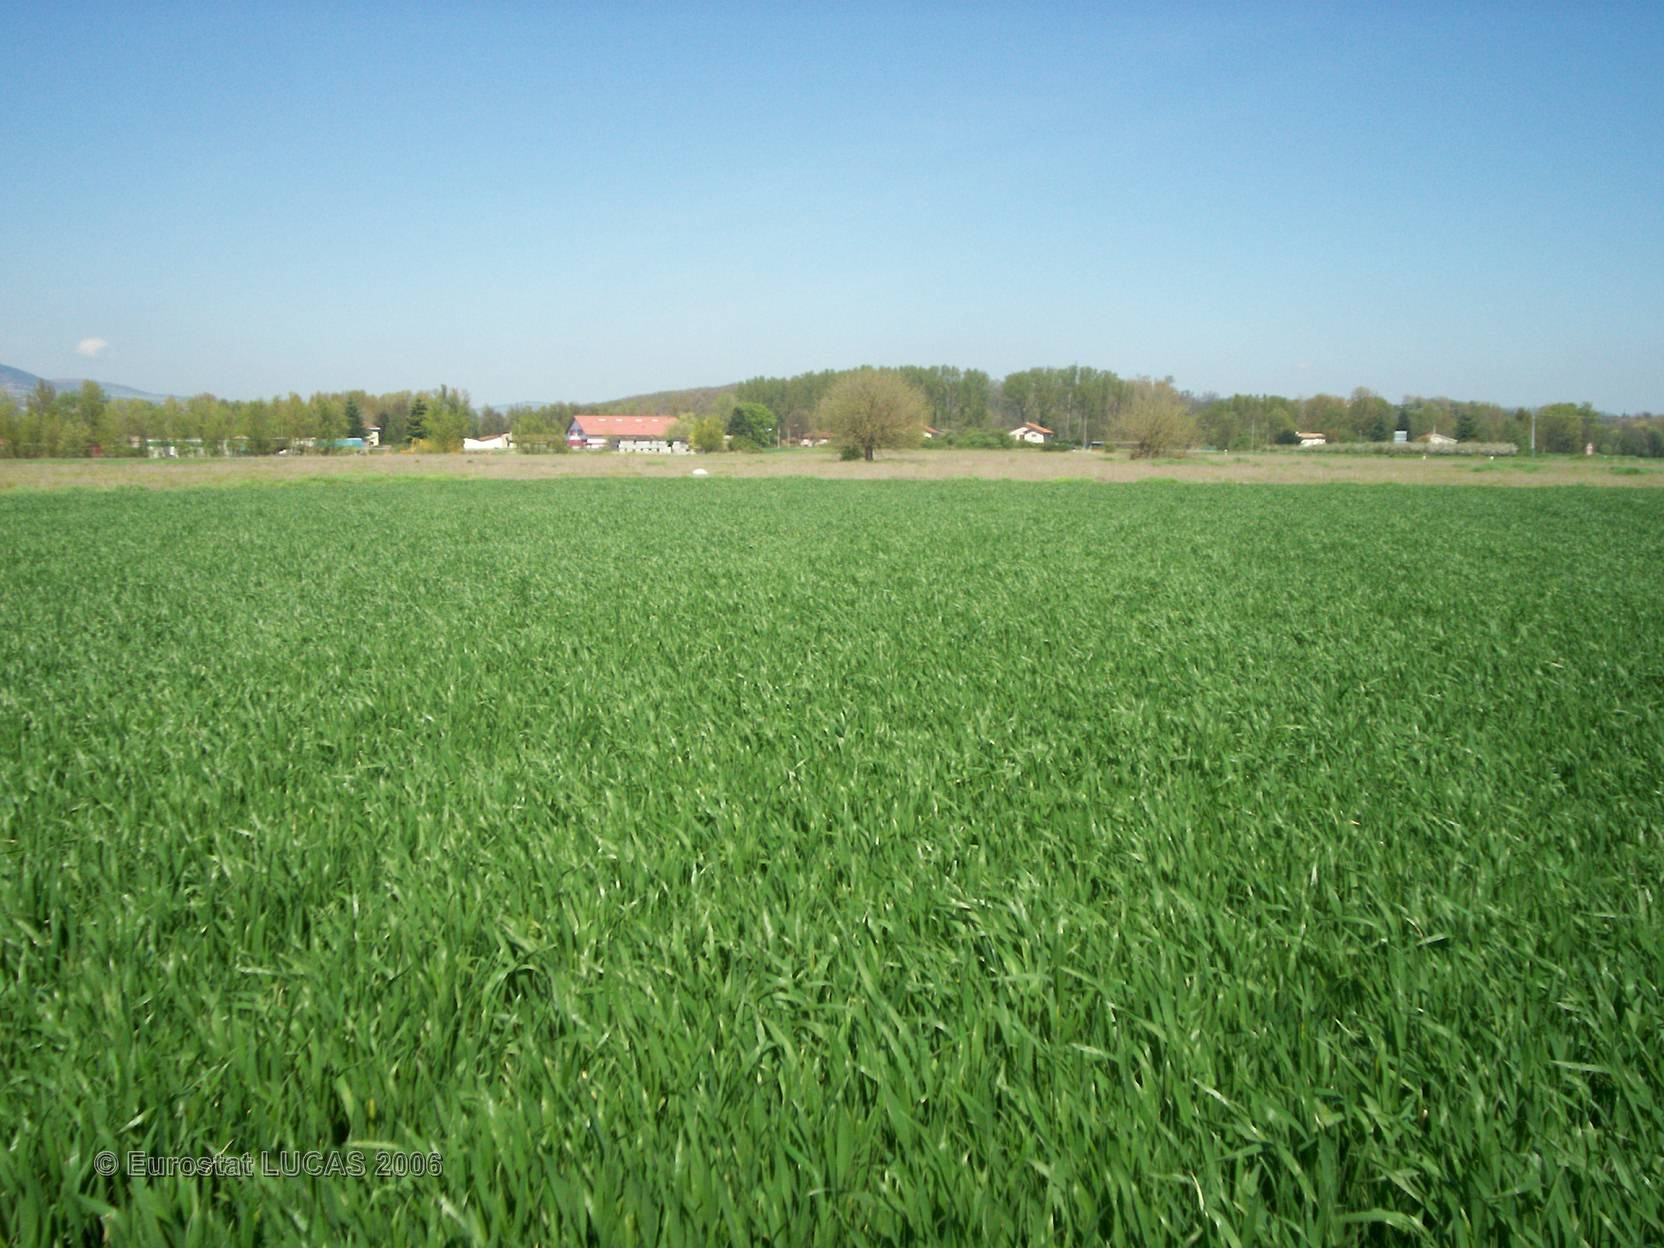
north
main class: Cropland
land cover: Triticale
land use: Agriculture (excluding fallow land and kitchen gardens)
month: April
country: FR
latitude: 45.4113
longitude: 4.7783
